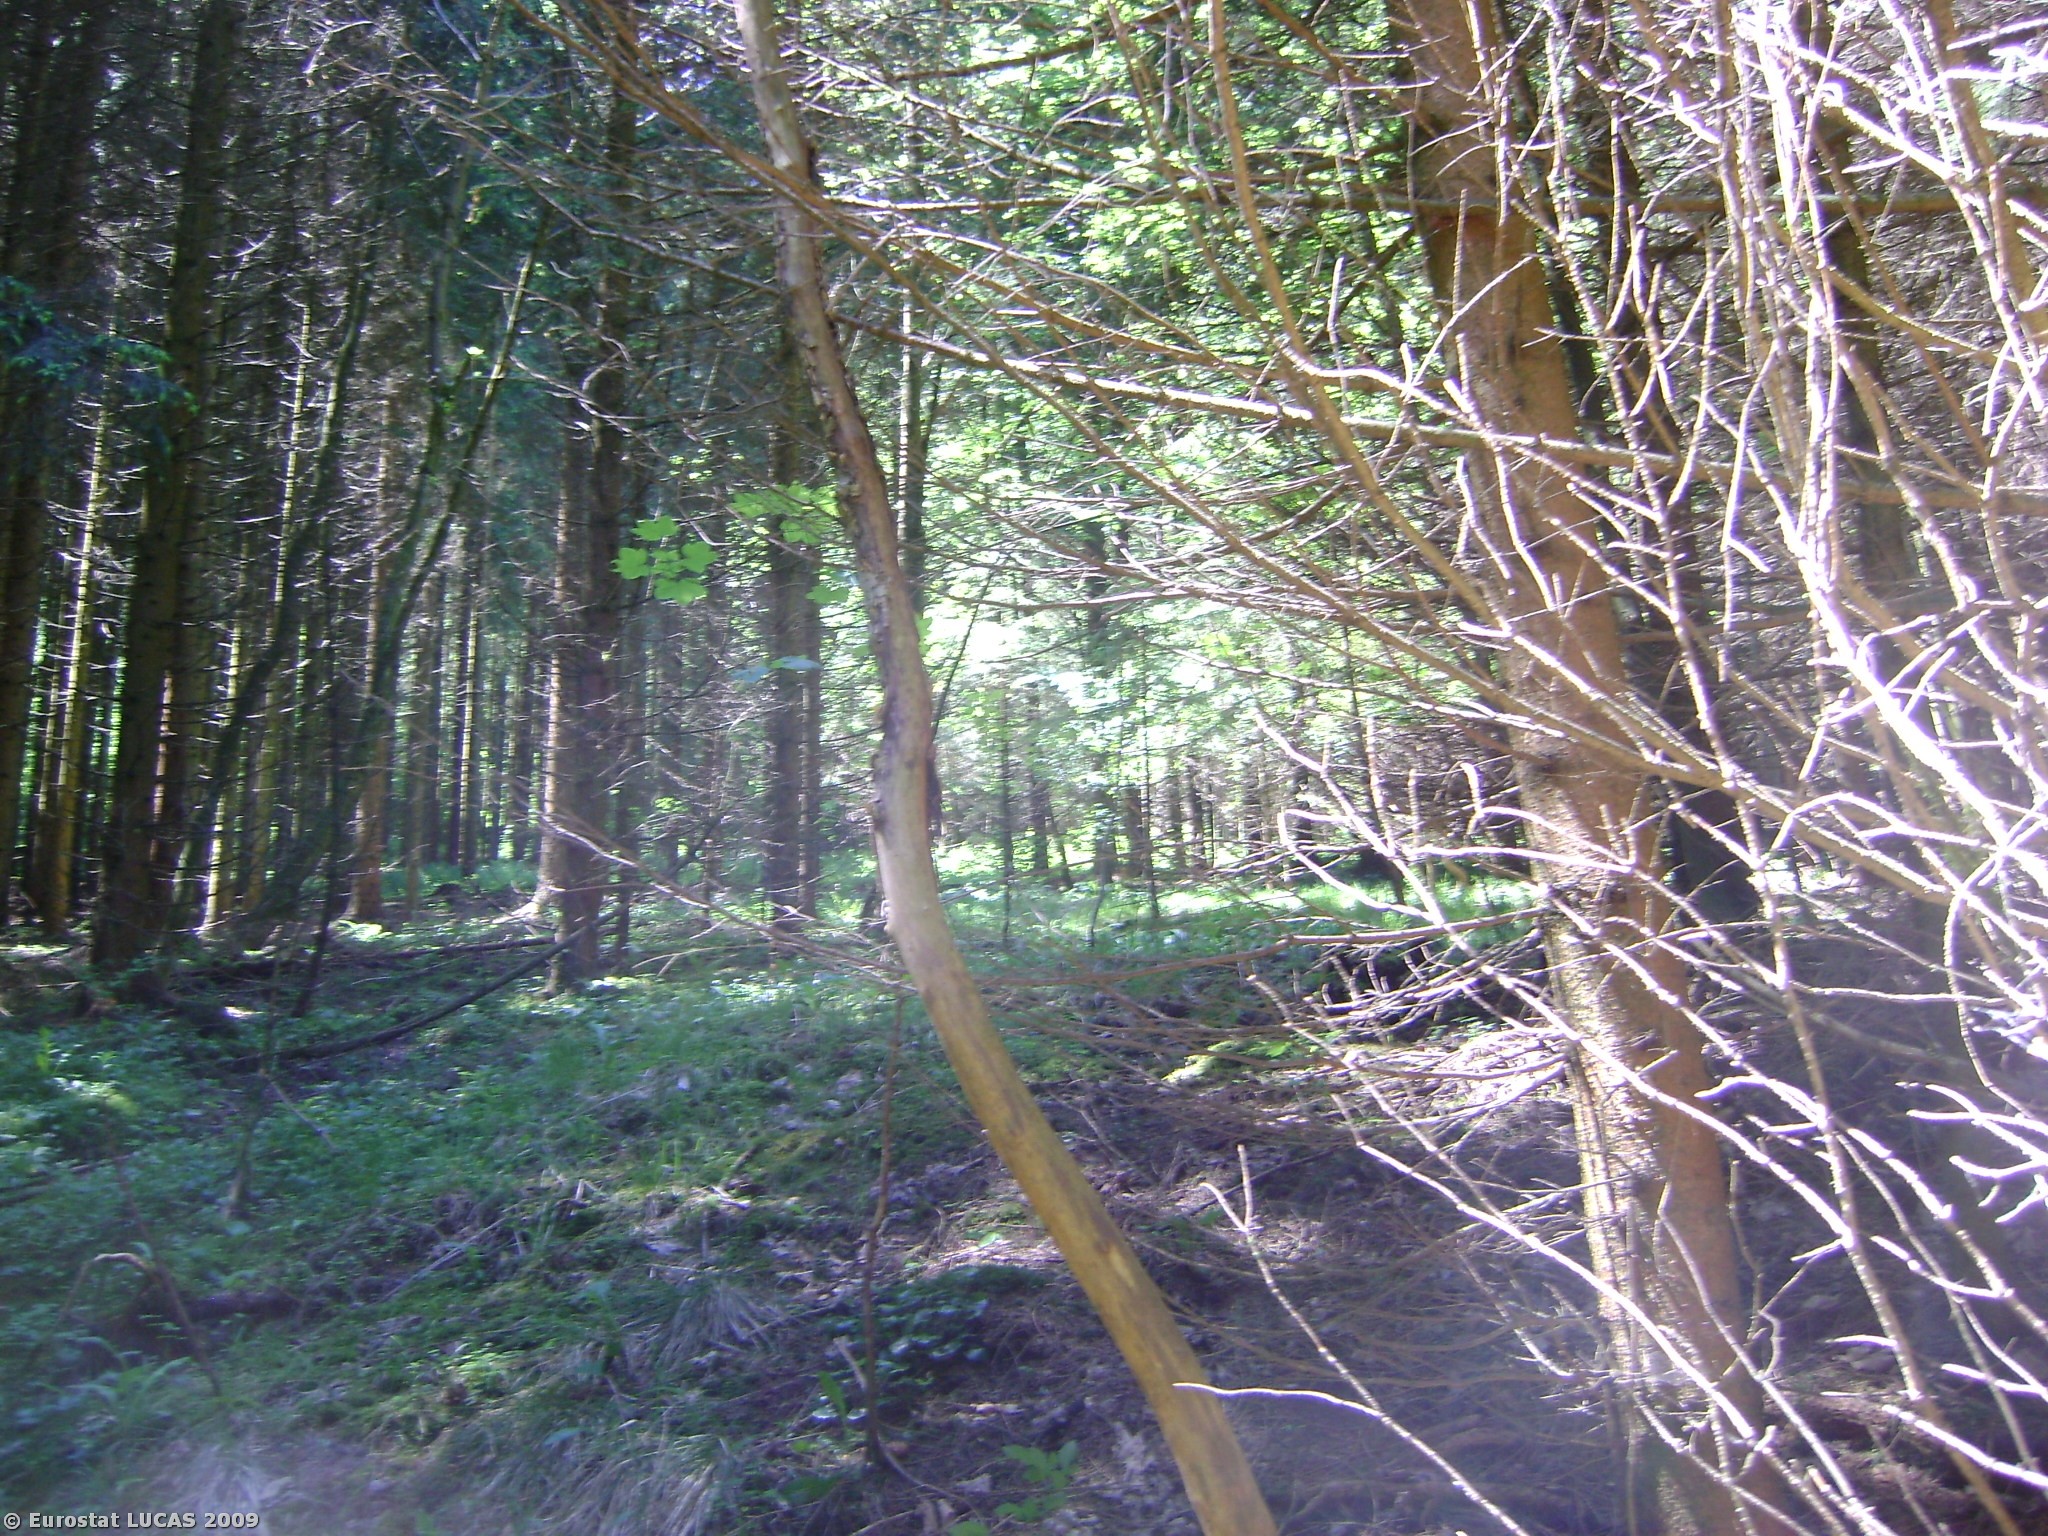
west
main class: Woodland
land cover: Coniferous woodland
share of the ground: > 75 %
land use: Forestry
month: May
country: AT
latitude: 47.8793
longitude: 13.5156
